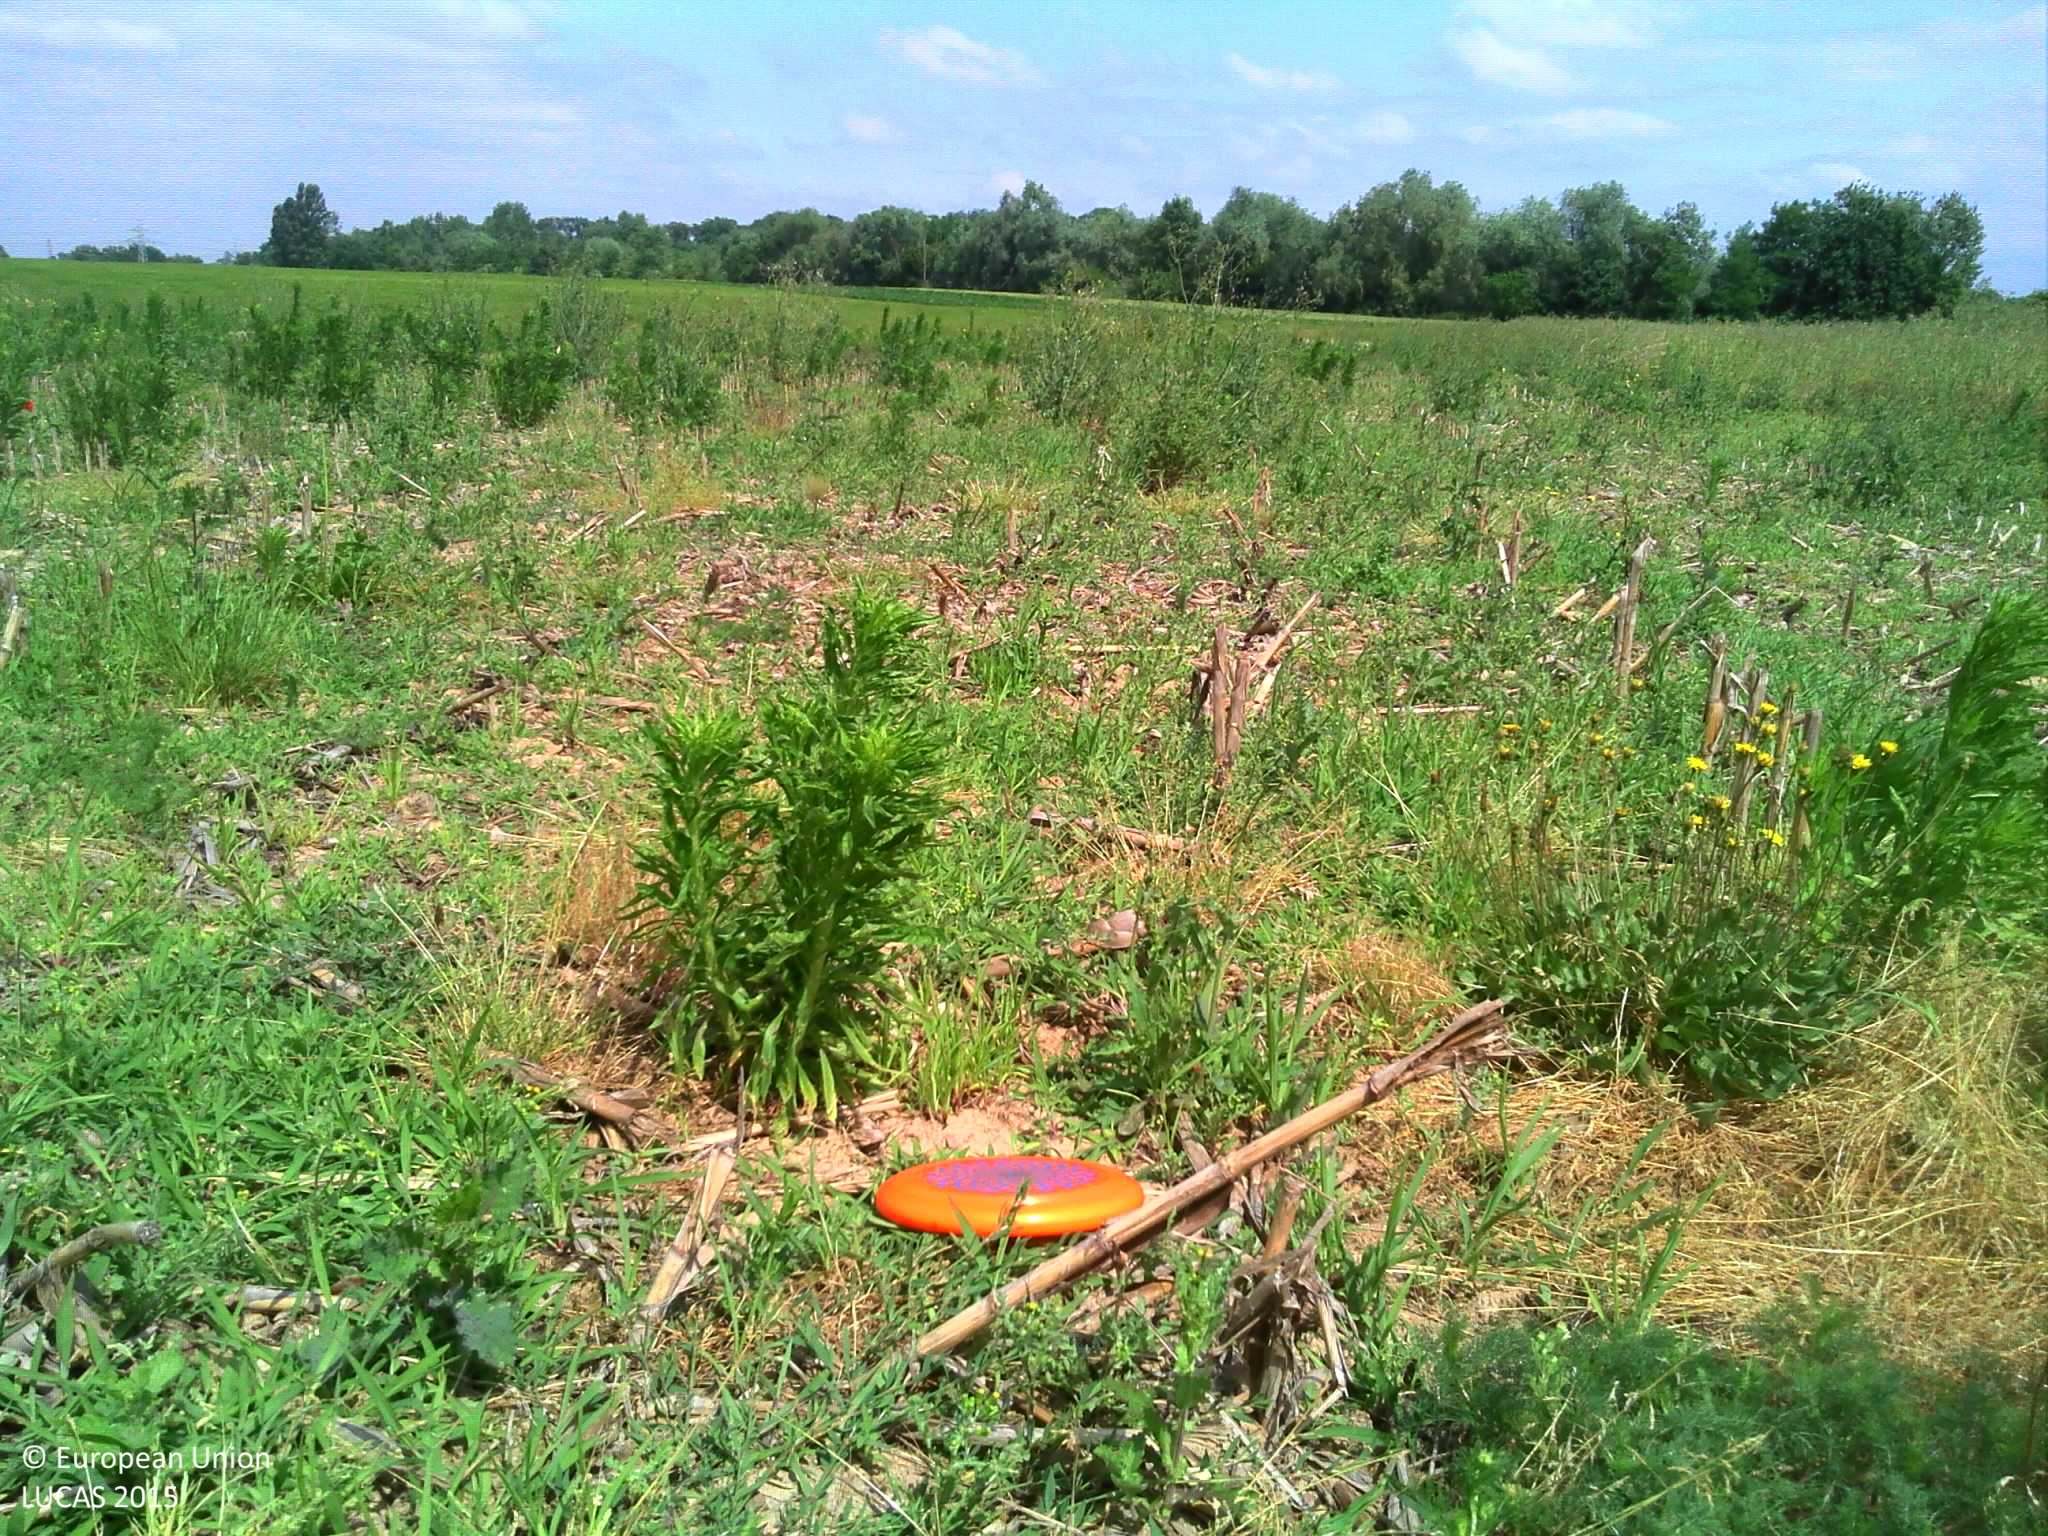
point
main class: Grassland
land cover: Spontaneously vegetated surfaces
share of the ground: > 75 %
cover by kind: herbaceous plants 100 %
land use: Fallow land
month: June
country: FR
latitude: 48.5587
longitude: 7.6568
